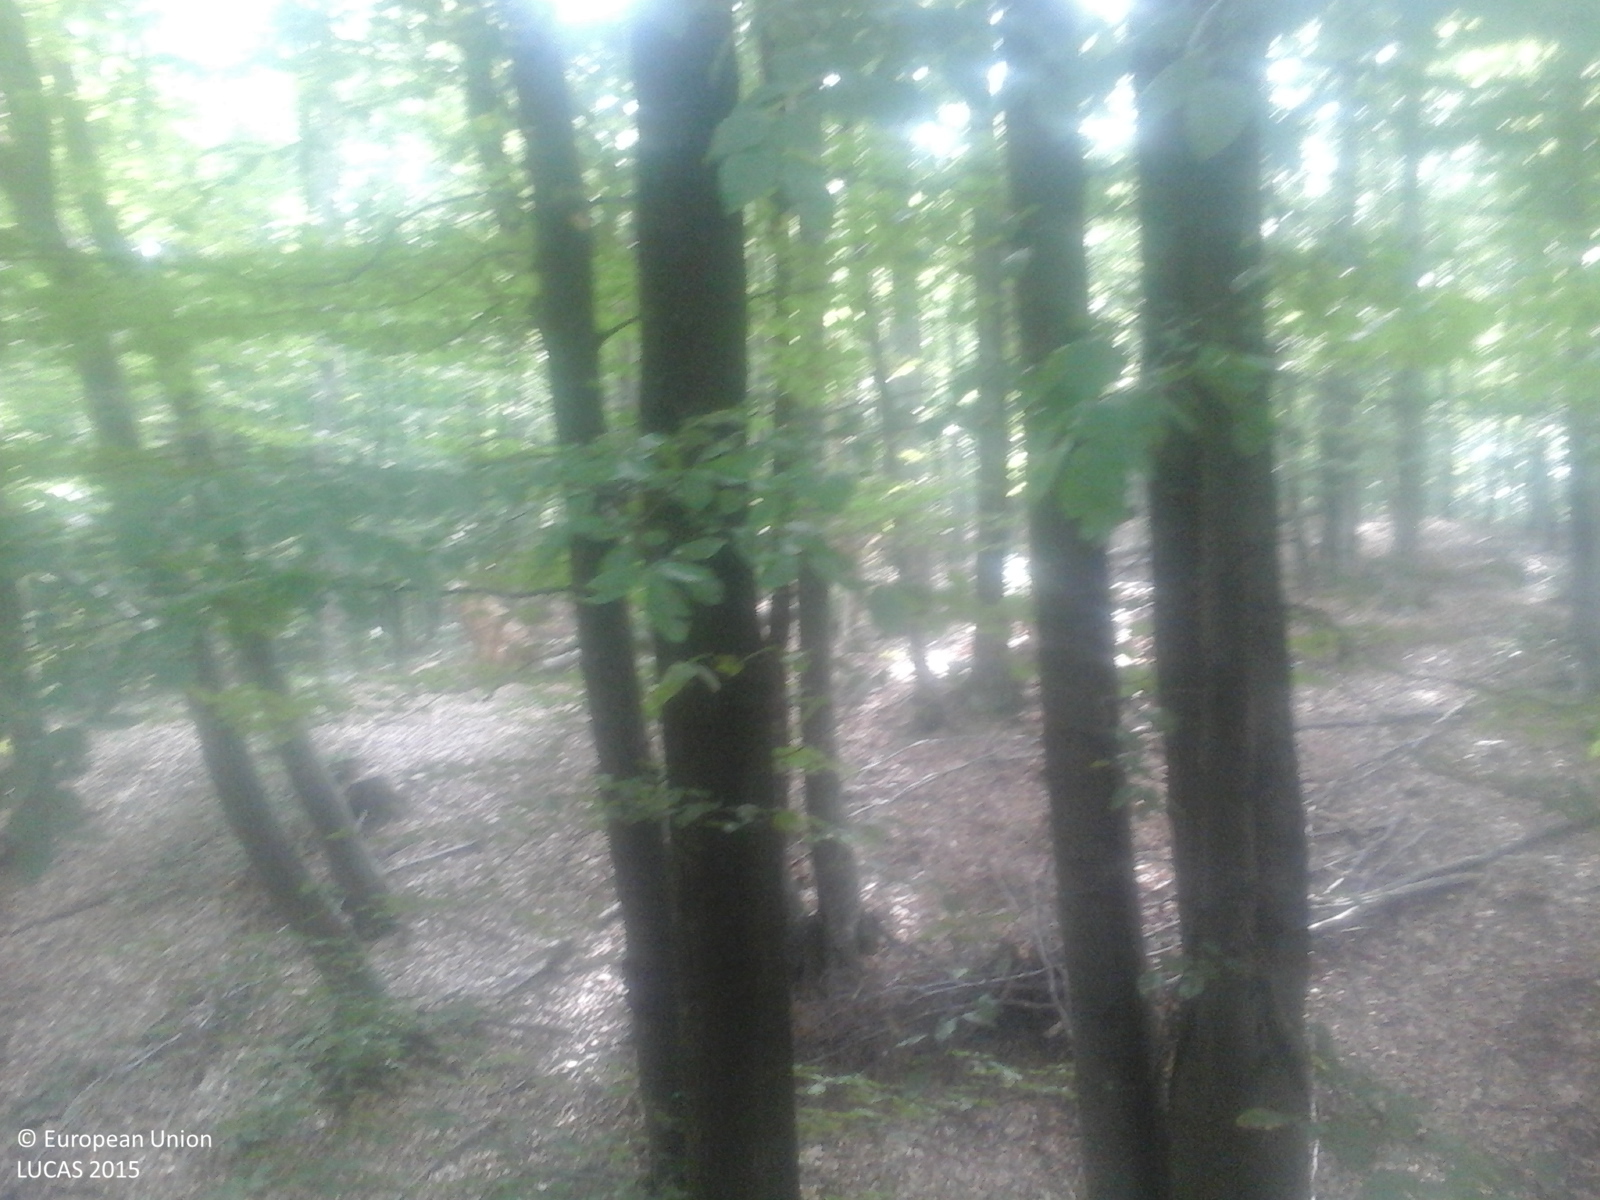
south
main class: Woodland
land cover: Broadleaved woodland
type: beech forest
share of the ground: > 75 %
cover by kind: broadleaved forest trees 100 %
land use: Forestry
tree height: > 5 m
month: September
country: RO
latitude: 47.1452
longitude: 23.1066
